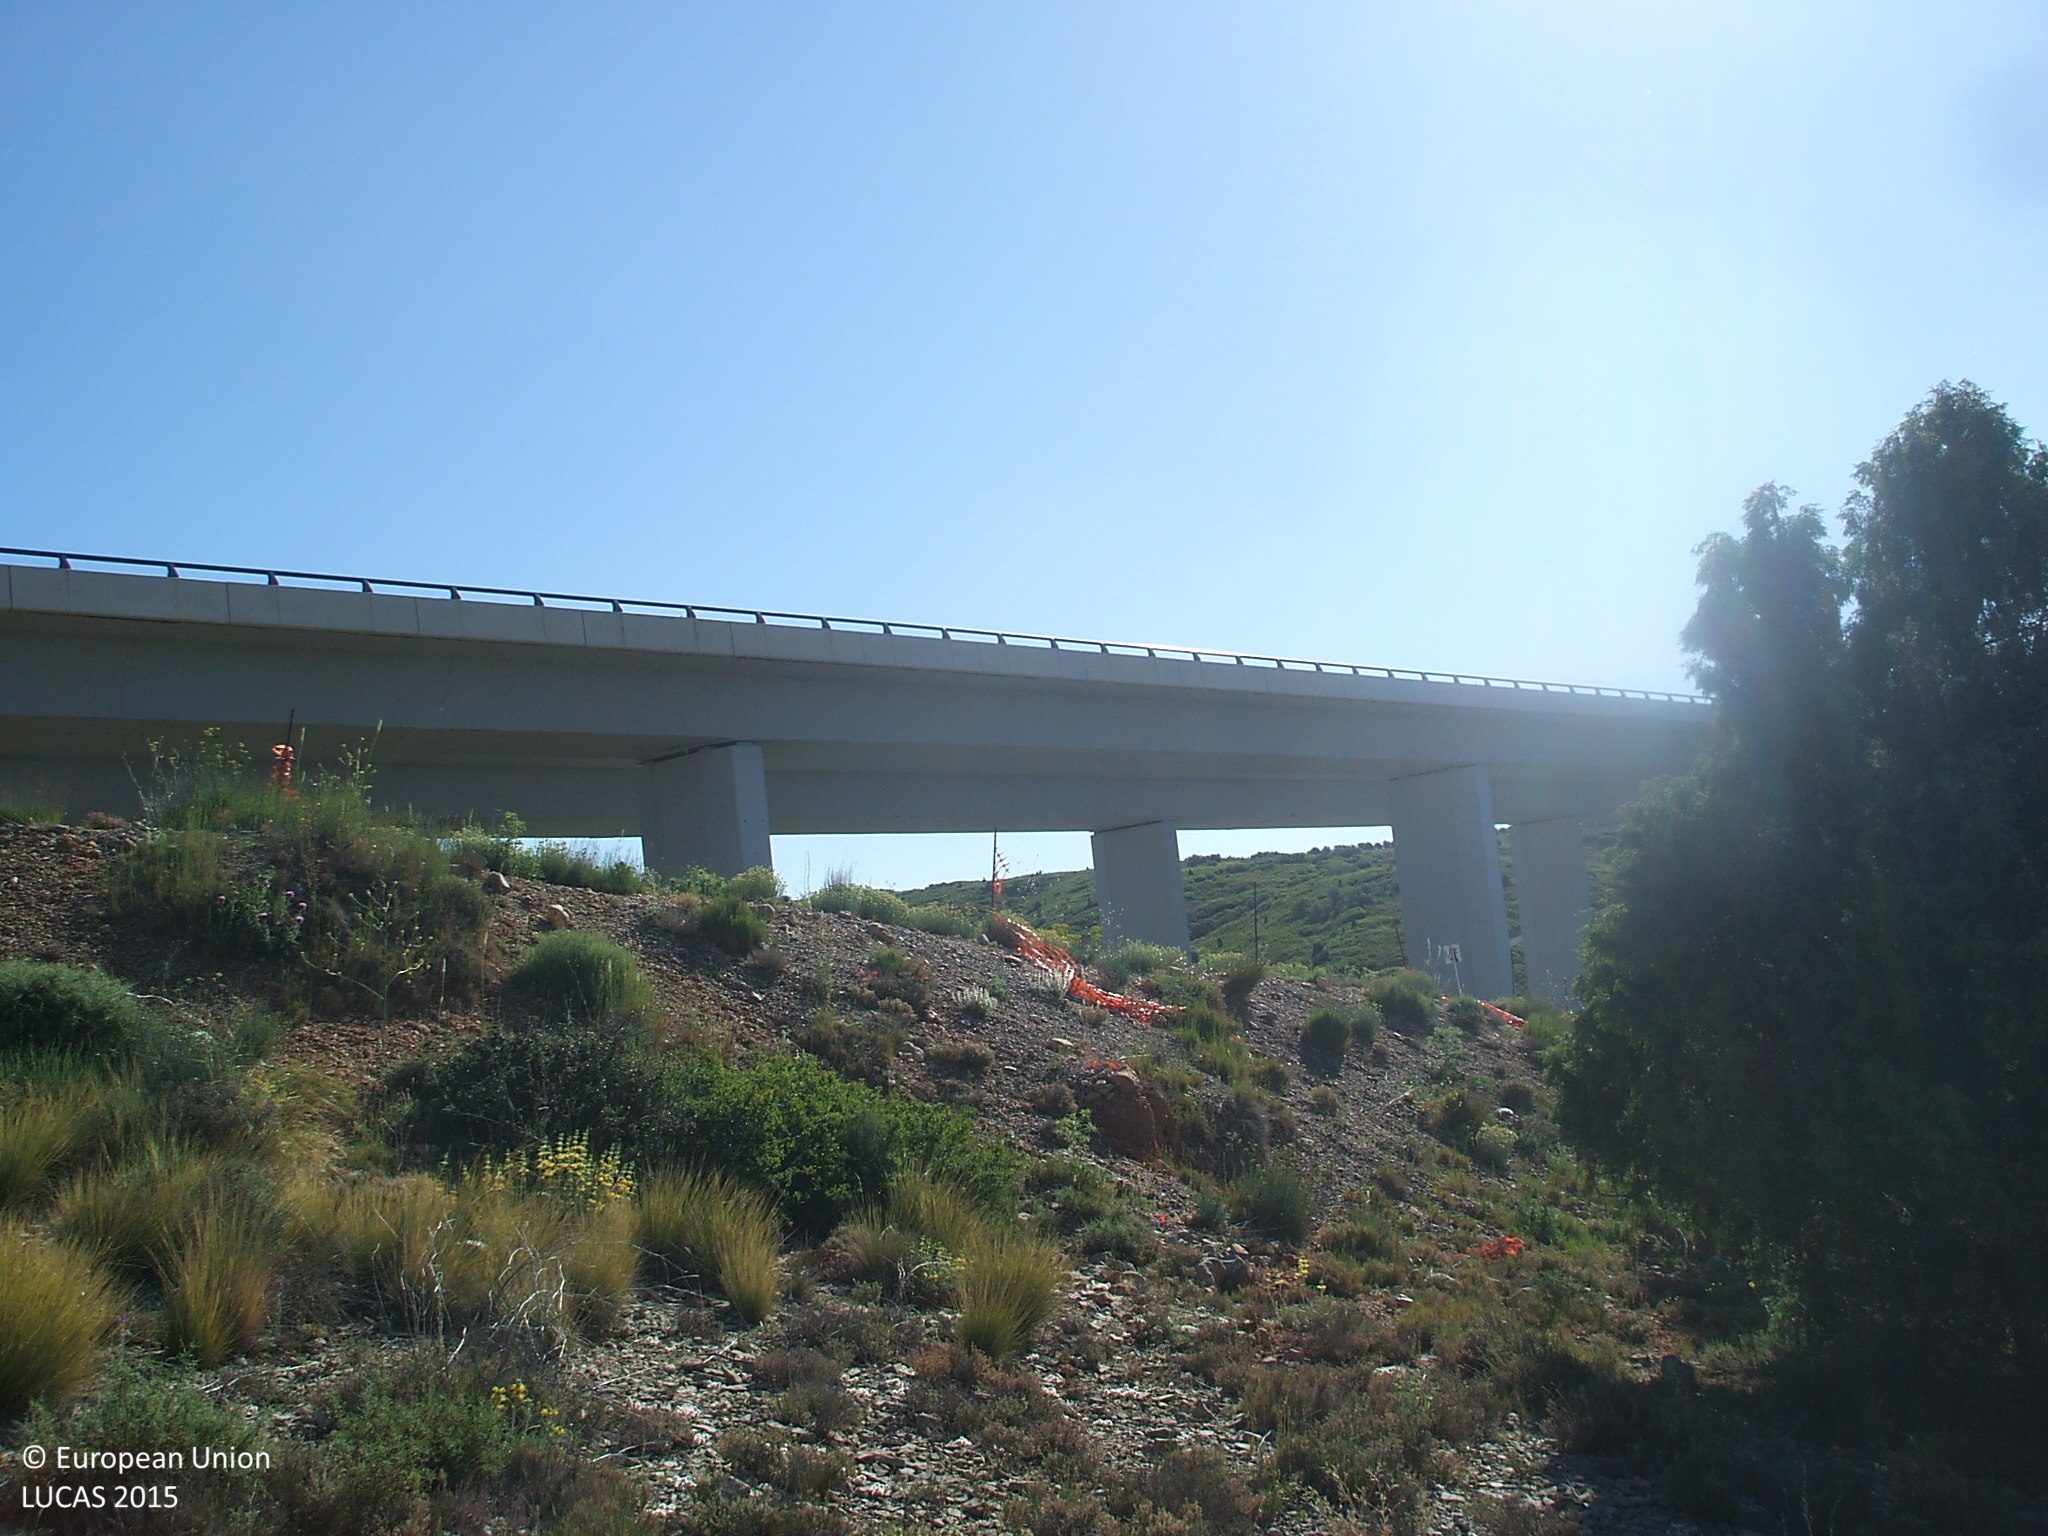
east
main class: Shrubland
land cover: Shrubland with sparse tree cover
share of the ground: 25 - 50 %
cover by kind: consolidated bare surface 75 %, shrubs 20 %, coniferous forest trees 5 %
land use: Semi-natural and natural areas not in use
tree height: < 5 m
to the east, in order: Shrubland with sparse tree cover; Tracks; Shrubland without tree cover; Tracks; Shrubland with sparse tree cover; Broadleaved woodland; Paved roads, cycling and walking lanes; Shrubland without tree cover; Paved roads, cycling and walking lanes
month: May
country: ES
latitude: 40.1289
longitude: -0.7675
